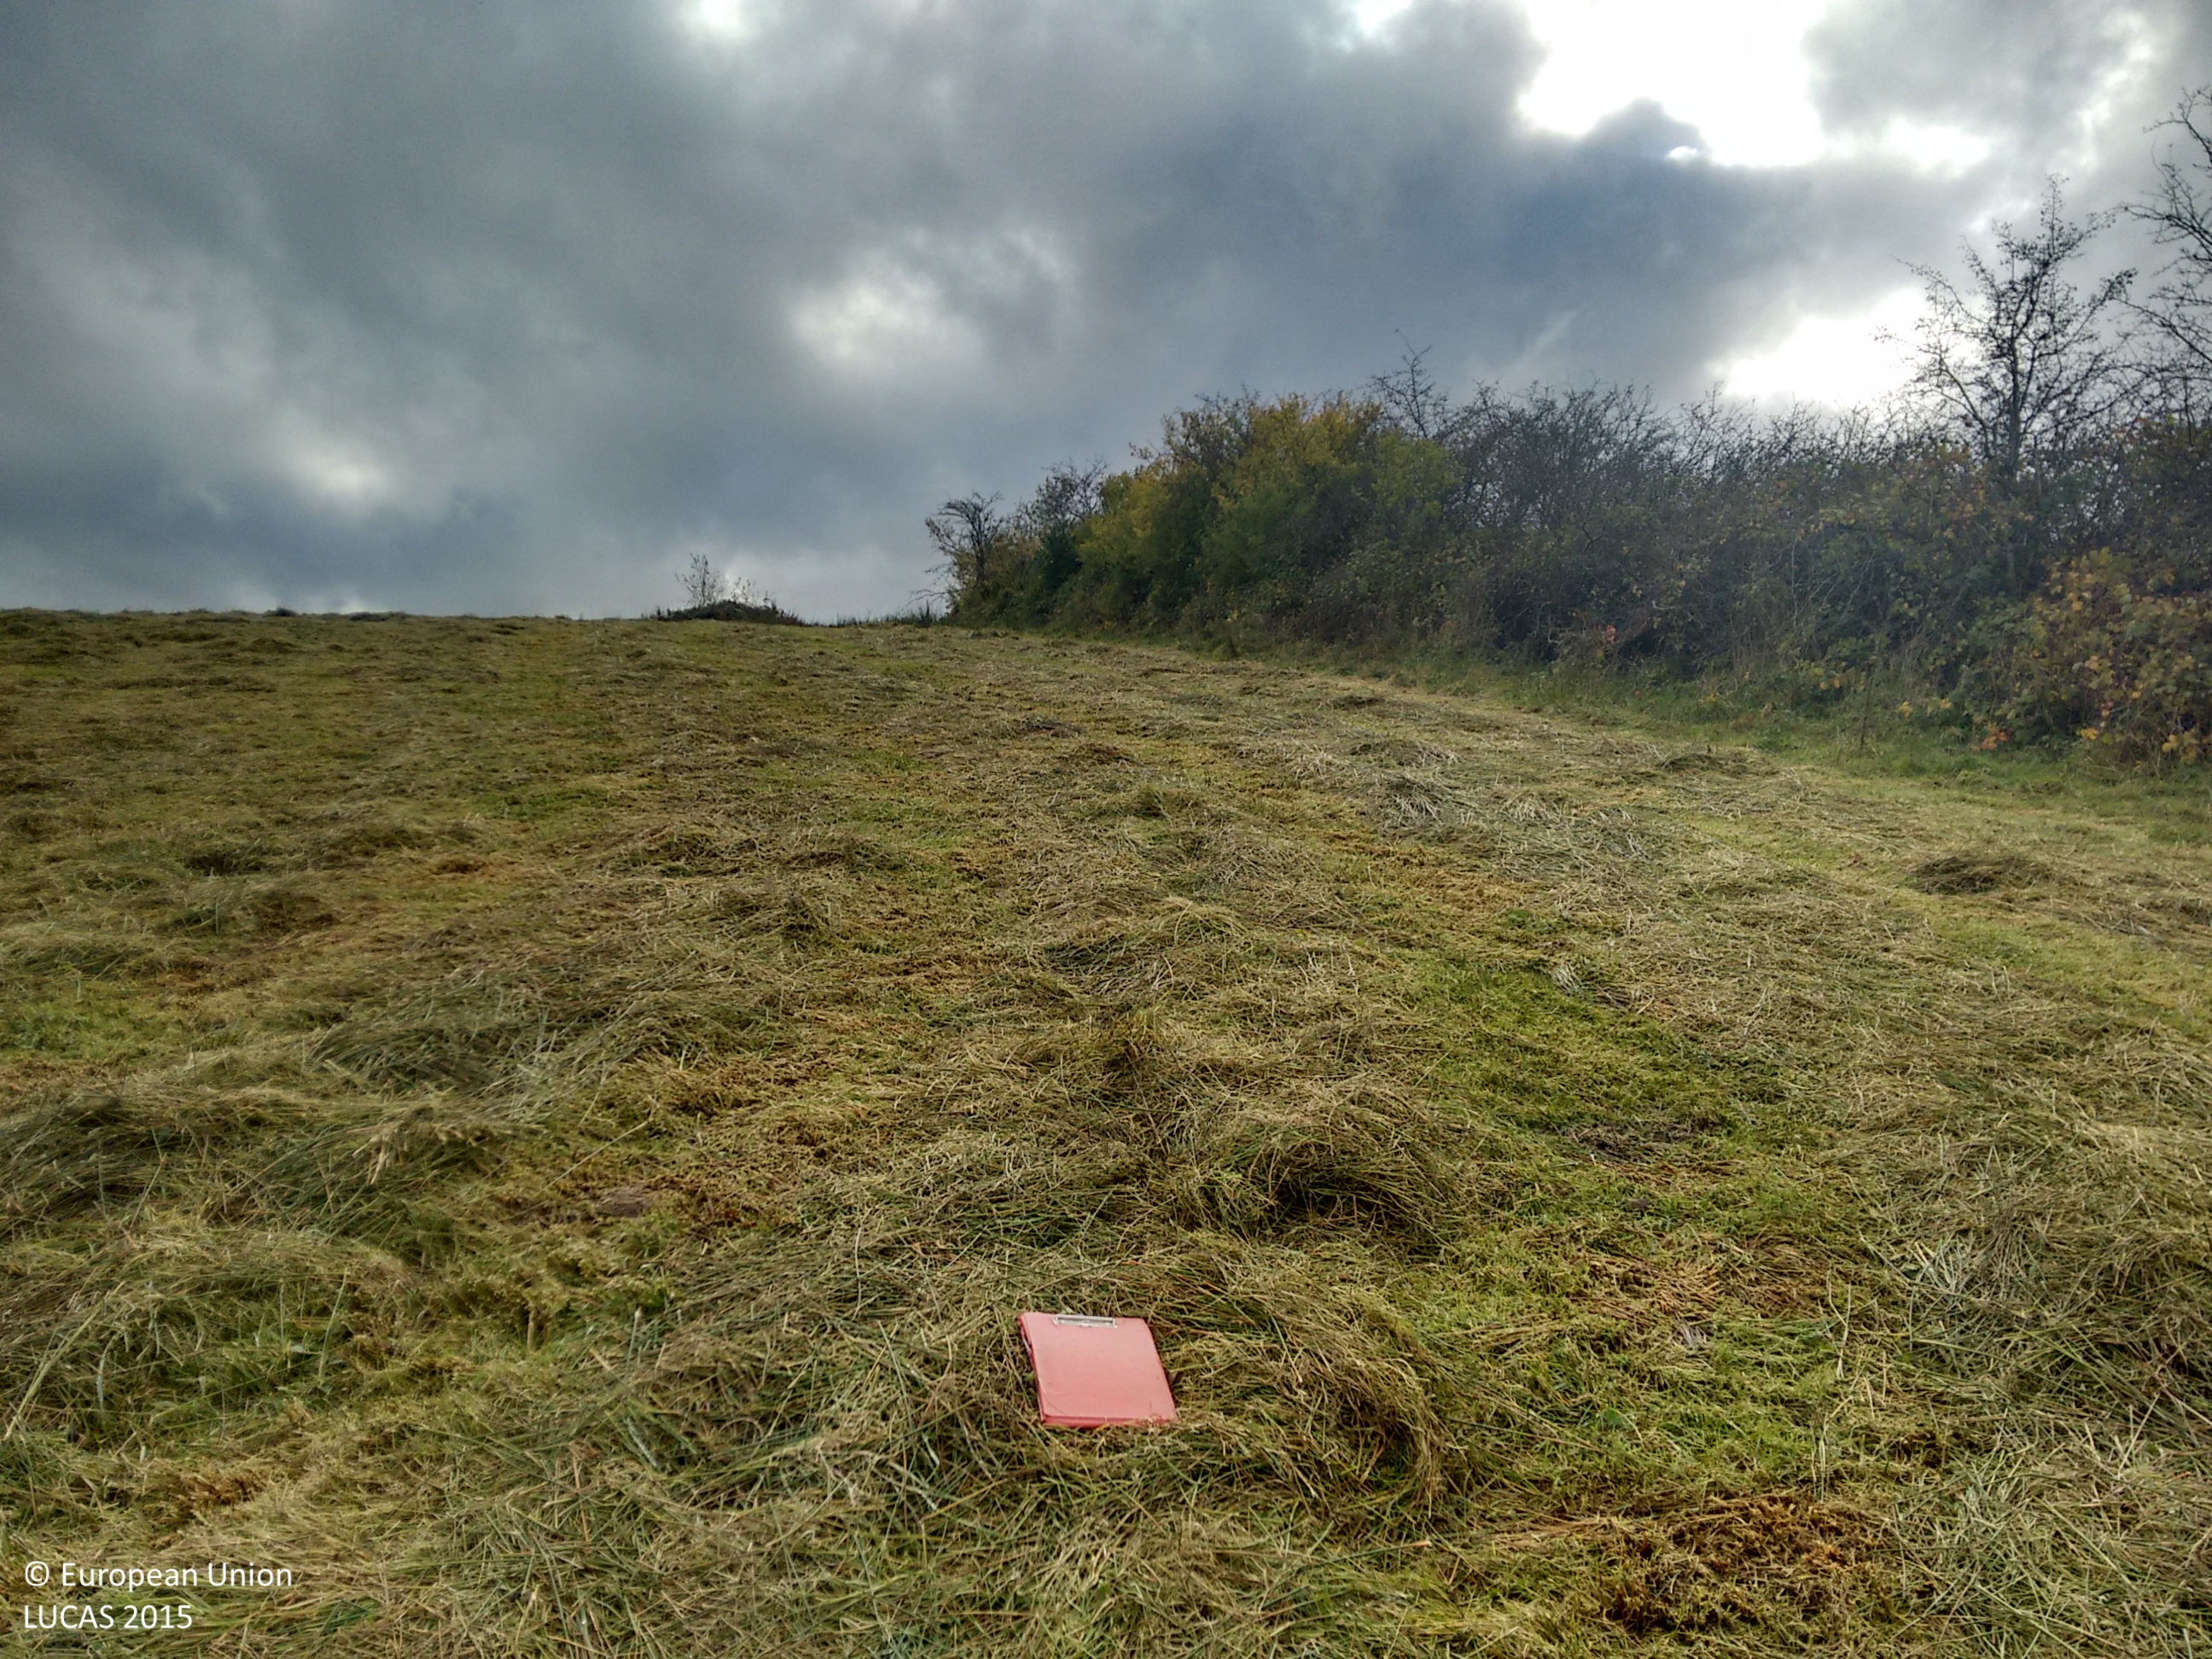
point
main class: Grassland
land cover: Grassland without tree/shrub cover
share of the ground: > 75 %
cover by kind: herbaceous plants 100 %
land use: Agriculture (excluding fallow land and kitchen gardens)
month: October
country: IE
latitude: 53.9917
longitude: -8.1312
